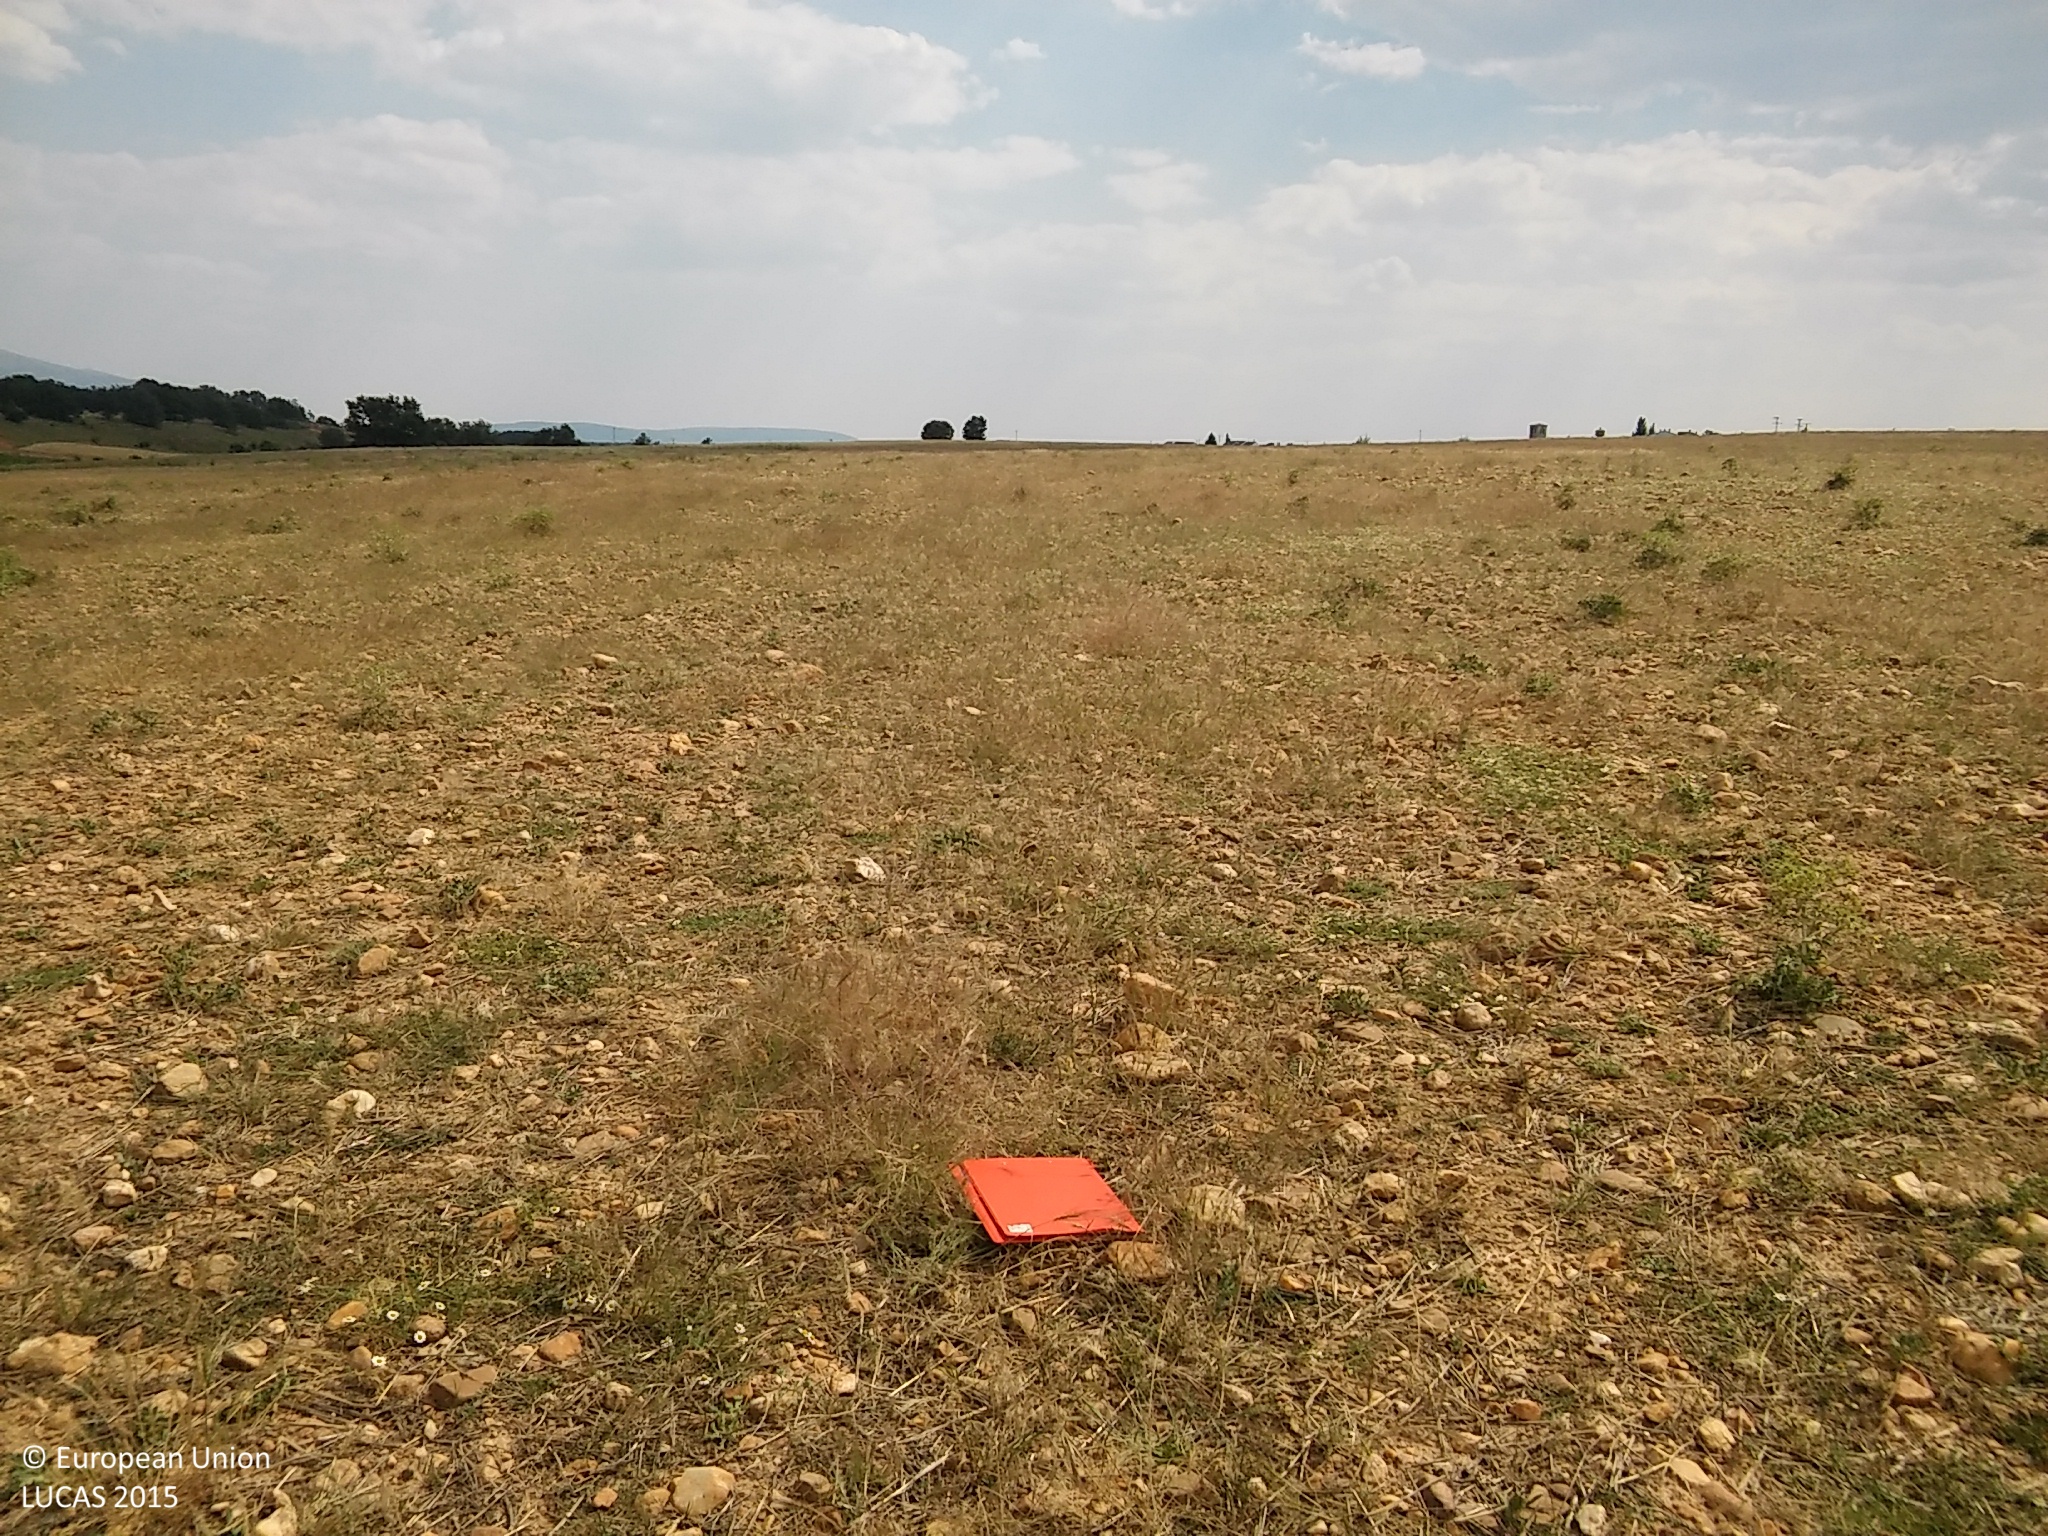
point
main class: Grassland
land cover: Spontaneously vegetated surfaces
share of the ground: 50 - 75 %
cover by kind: herbaceous plants 60 %, unconsolidated bare surface 40 %
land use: Agriculture (excluding fallow land and kitchen gardens)
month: June
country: ES
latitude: 41.3315
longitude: -3.5850
